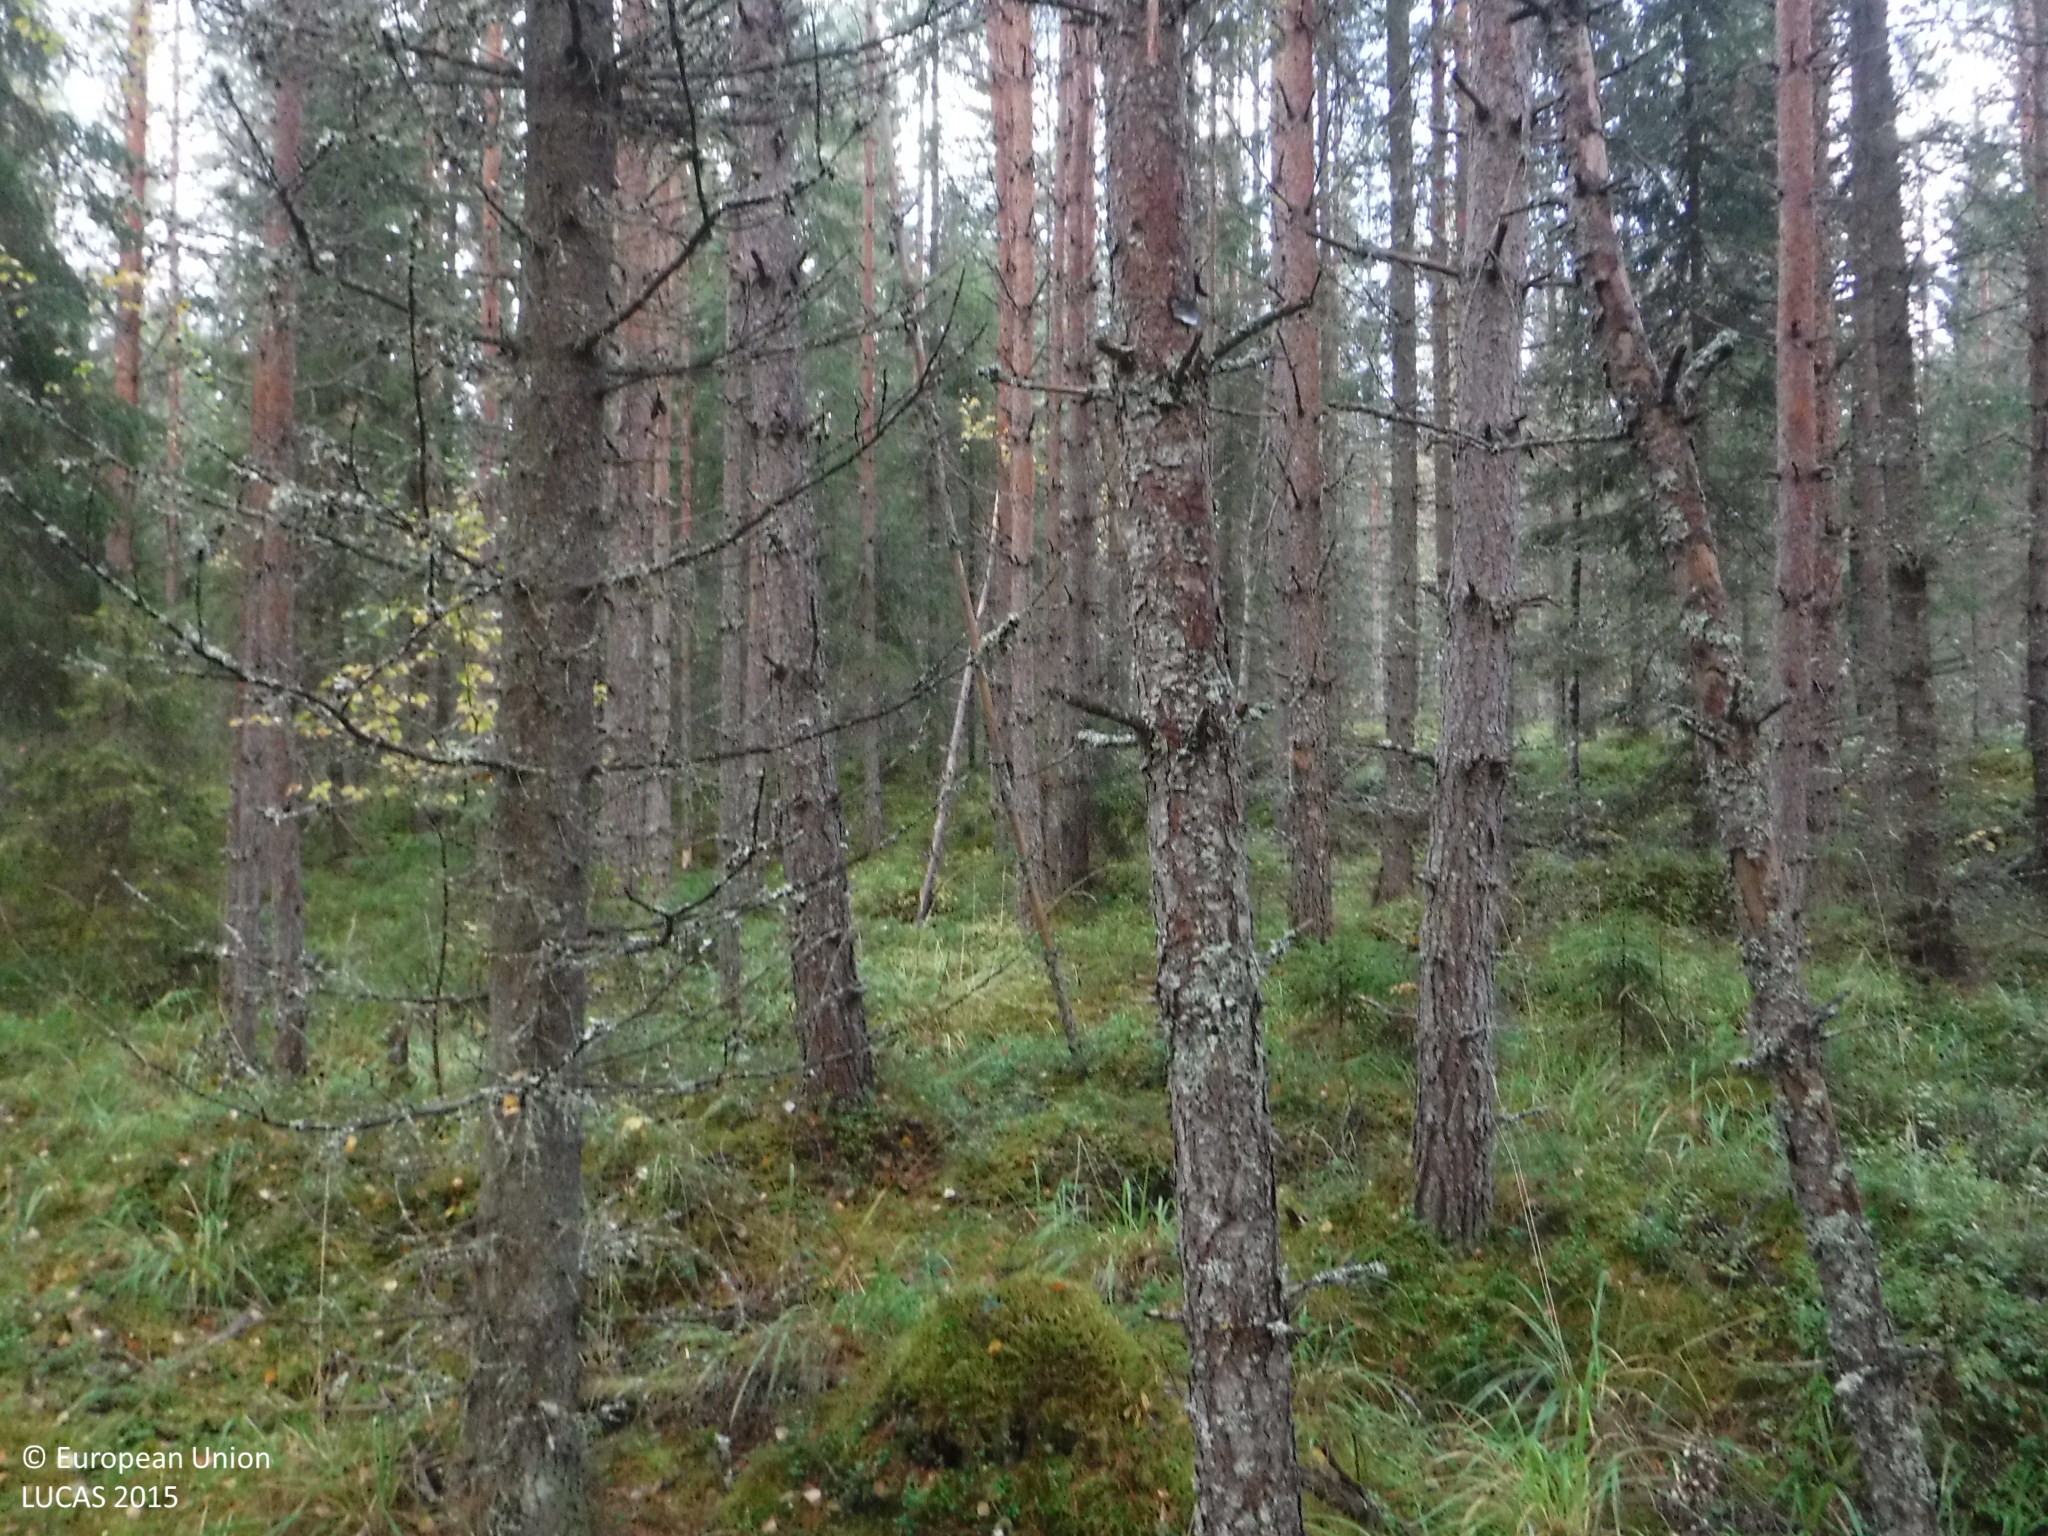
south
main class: Woodland
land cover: Other coniferous woodland
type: boreal forest
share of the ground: 50 - 75 %
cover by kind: coniferous forest trees 70 %, lichens and mosses 20 %, shrubs 10 %
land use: Amenities, museums, leisure
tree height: > 5 m
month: September
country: FI
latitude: 61.6805
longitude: 24.1680
